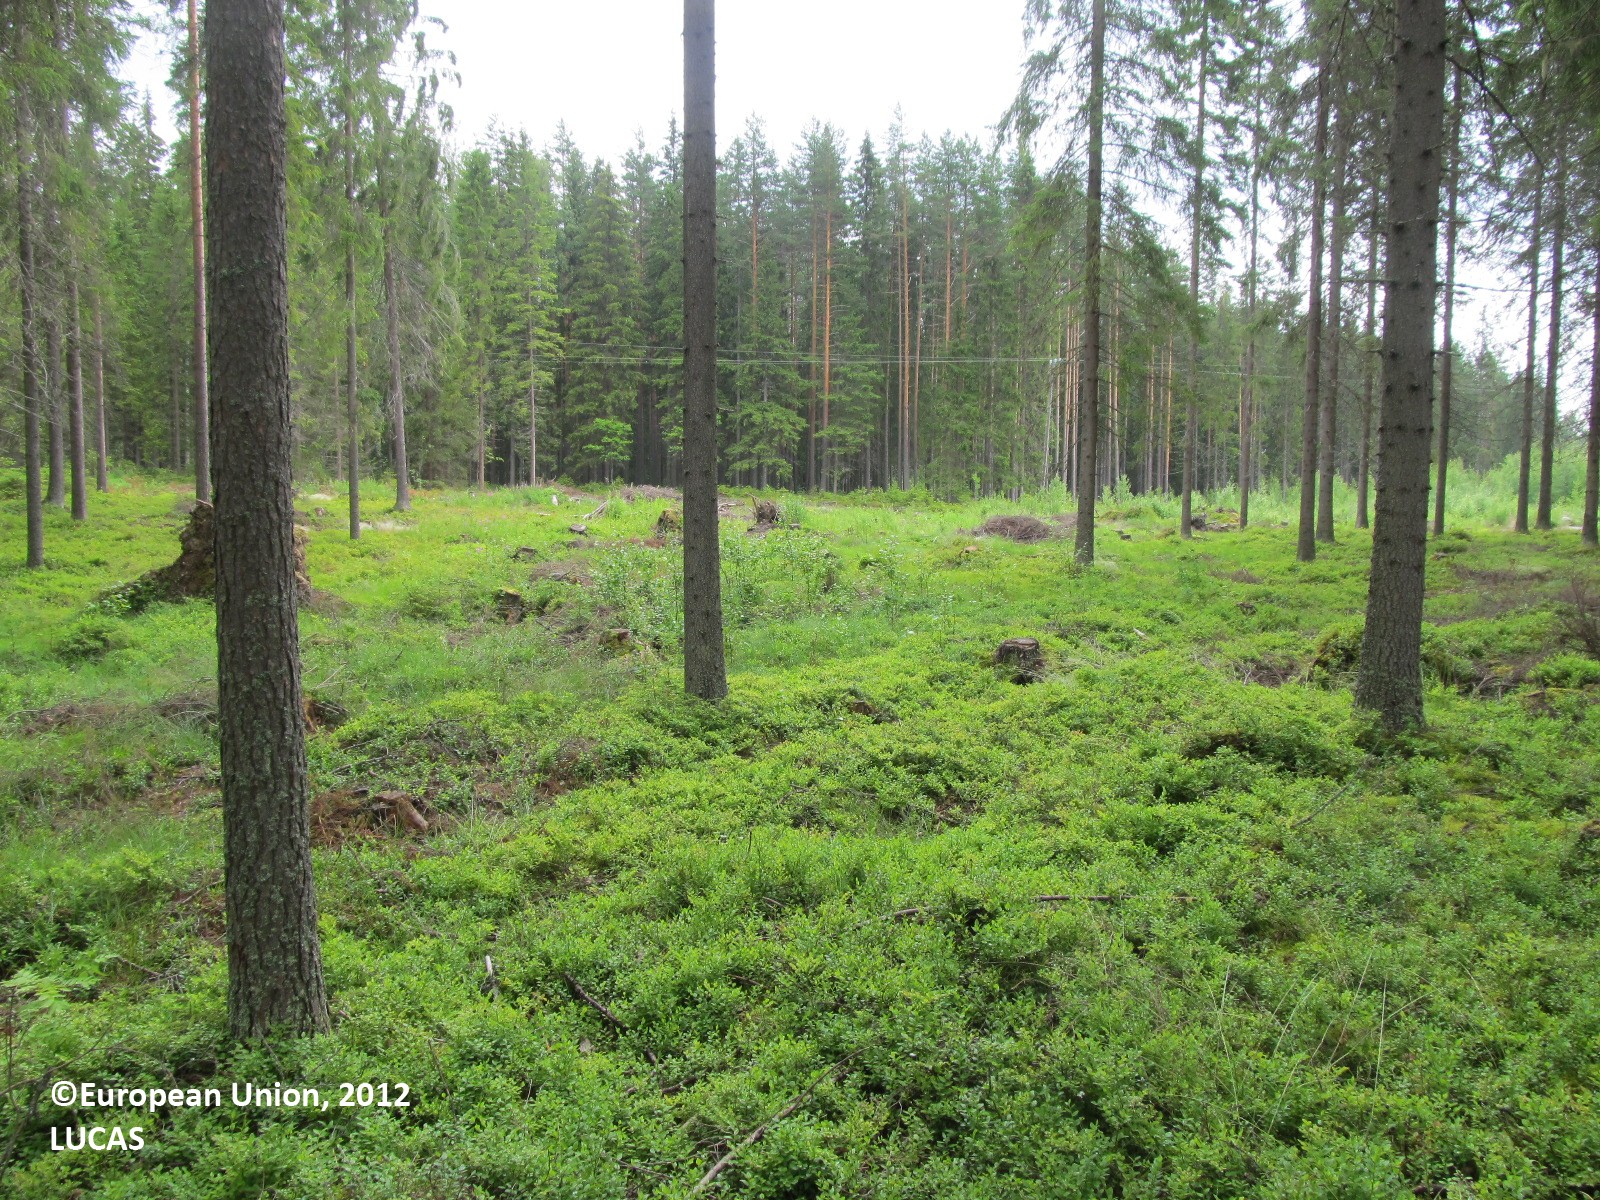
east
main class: Woodland
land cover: Spruce dominated coniferous woodland
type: boreal forest
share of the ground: 25 - 50 %
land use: Forestry
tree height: > 5 m
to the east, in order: Spruce dominated coniferous woodland; Tracks; Spruce dominated coniferous woodland; Tracks; Electric lines; Tracks; Spruce dominated coniferous woodland; Ditches and canals; Spruce dominated coniferous woodland
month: July
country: FI
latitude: 61.8884
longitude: 28.4109
